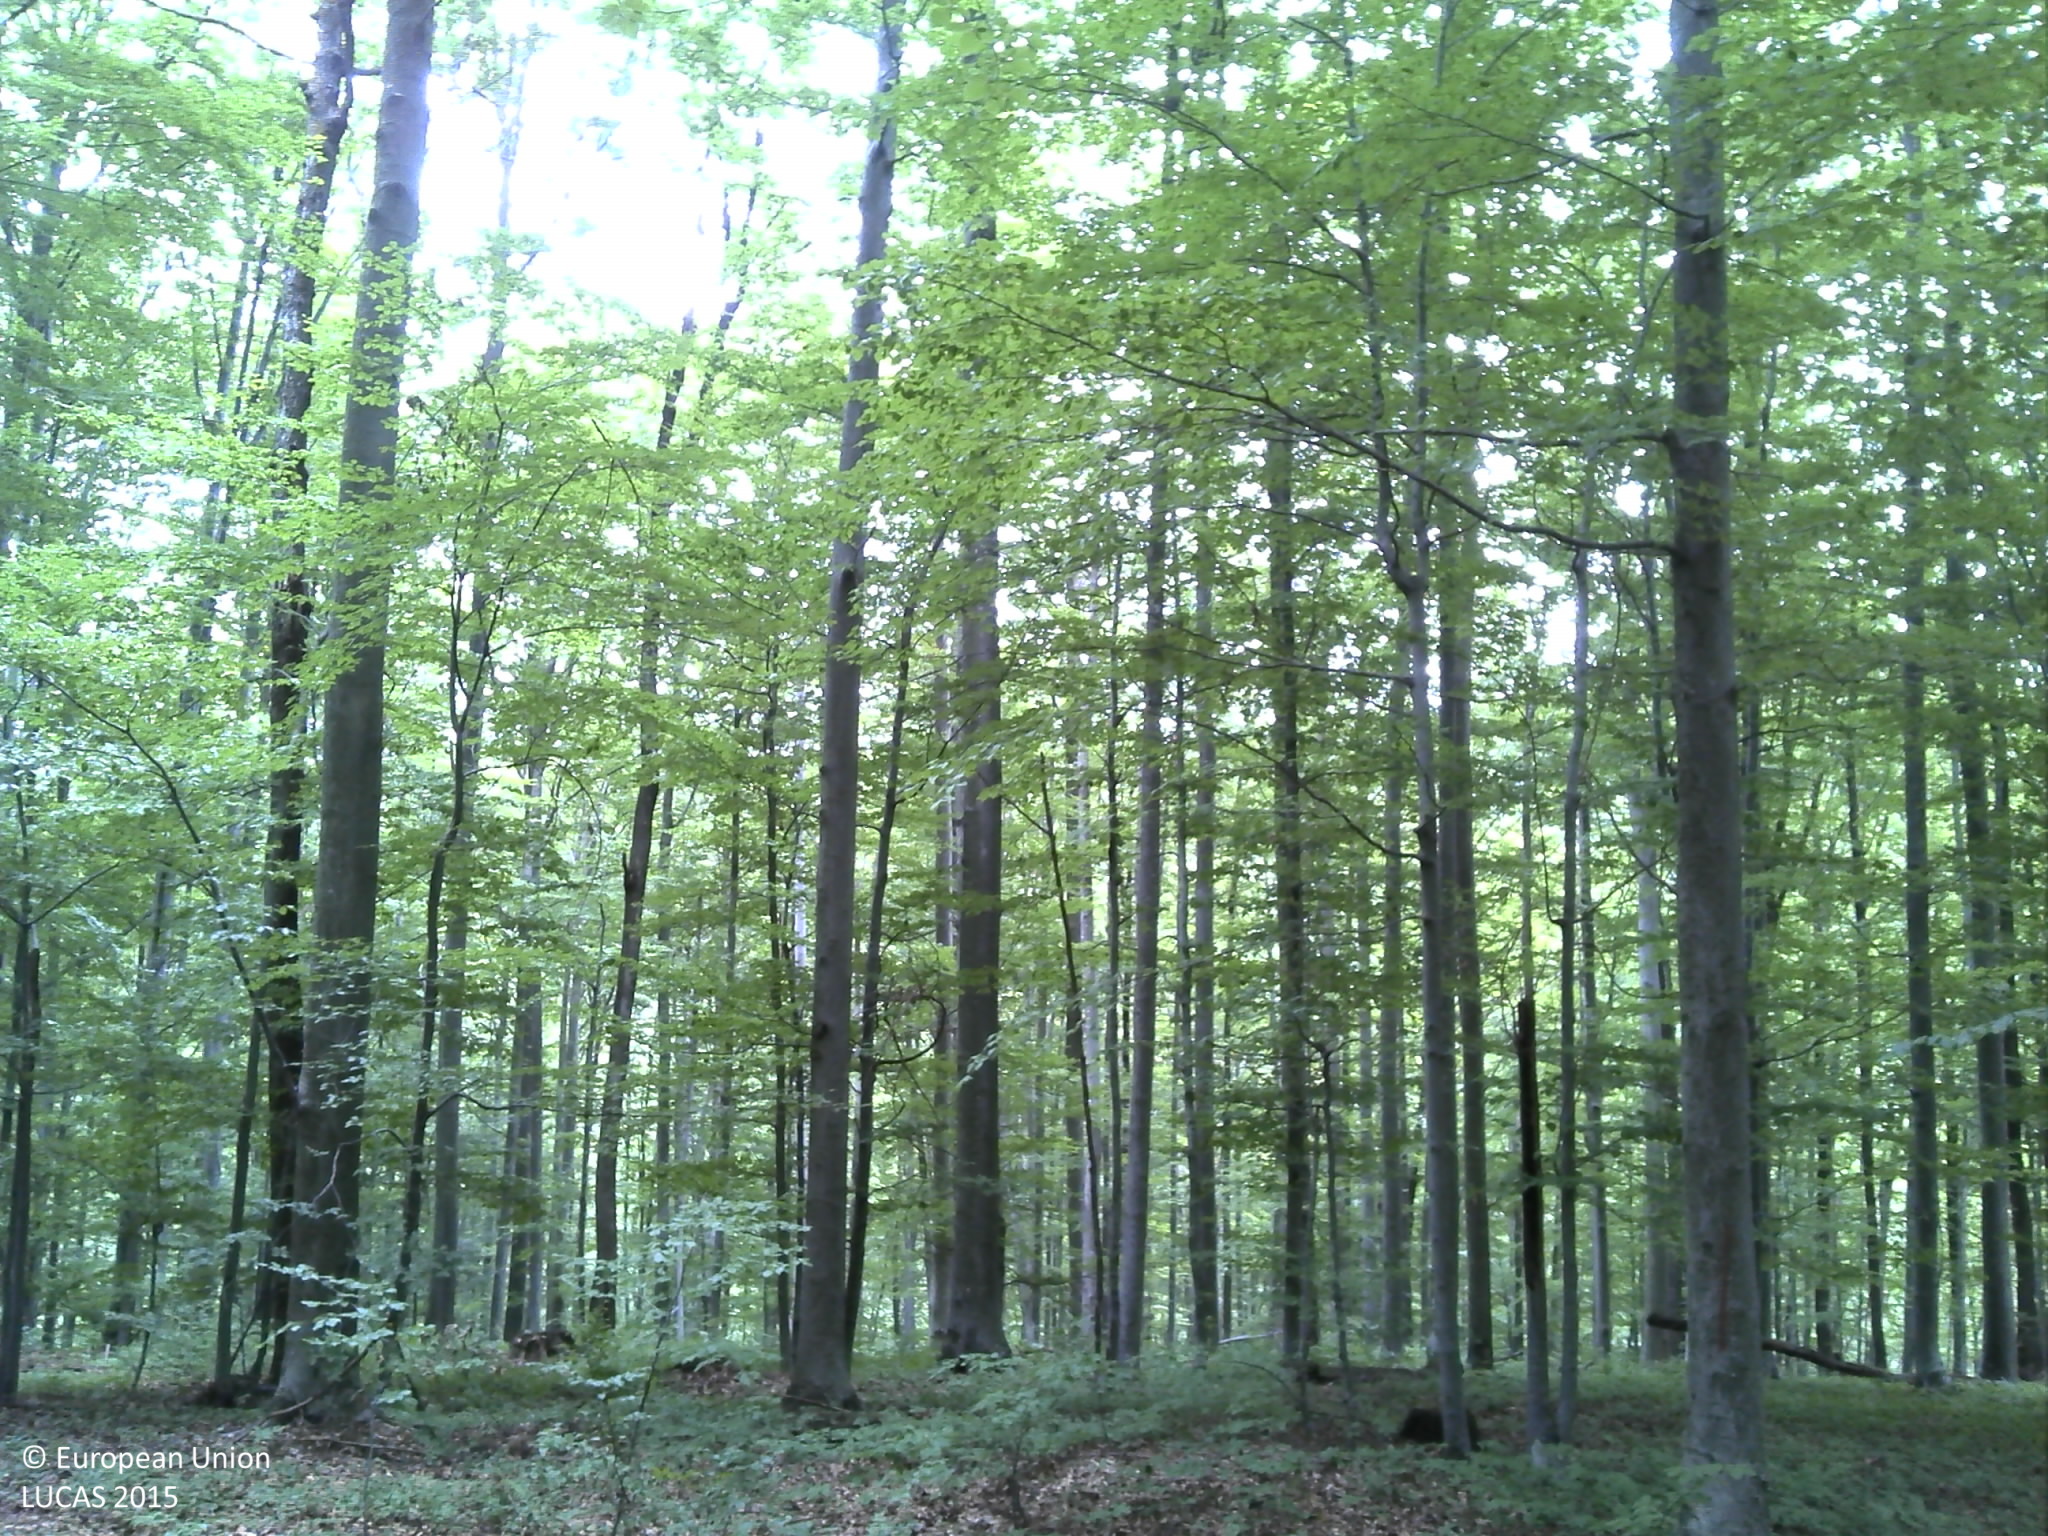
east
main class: Woodland
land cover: Broadleaved woodland
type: beech forest
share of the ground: > 75 %
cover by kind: broadleaved forest trees 100 %
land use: Forestry
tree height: > 5 m
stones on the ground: < 10 %
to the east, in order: Broadleaved woodland; Shruby margins; Tracks; Grass margins
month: August
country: HR
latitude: 45.3103
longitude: 15.7740
